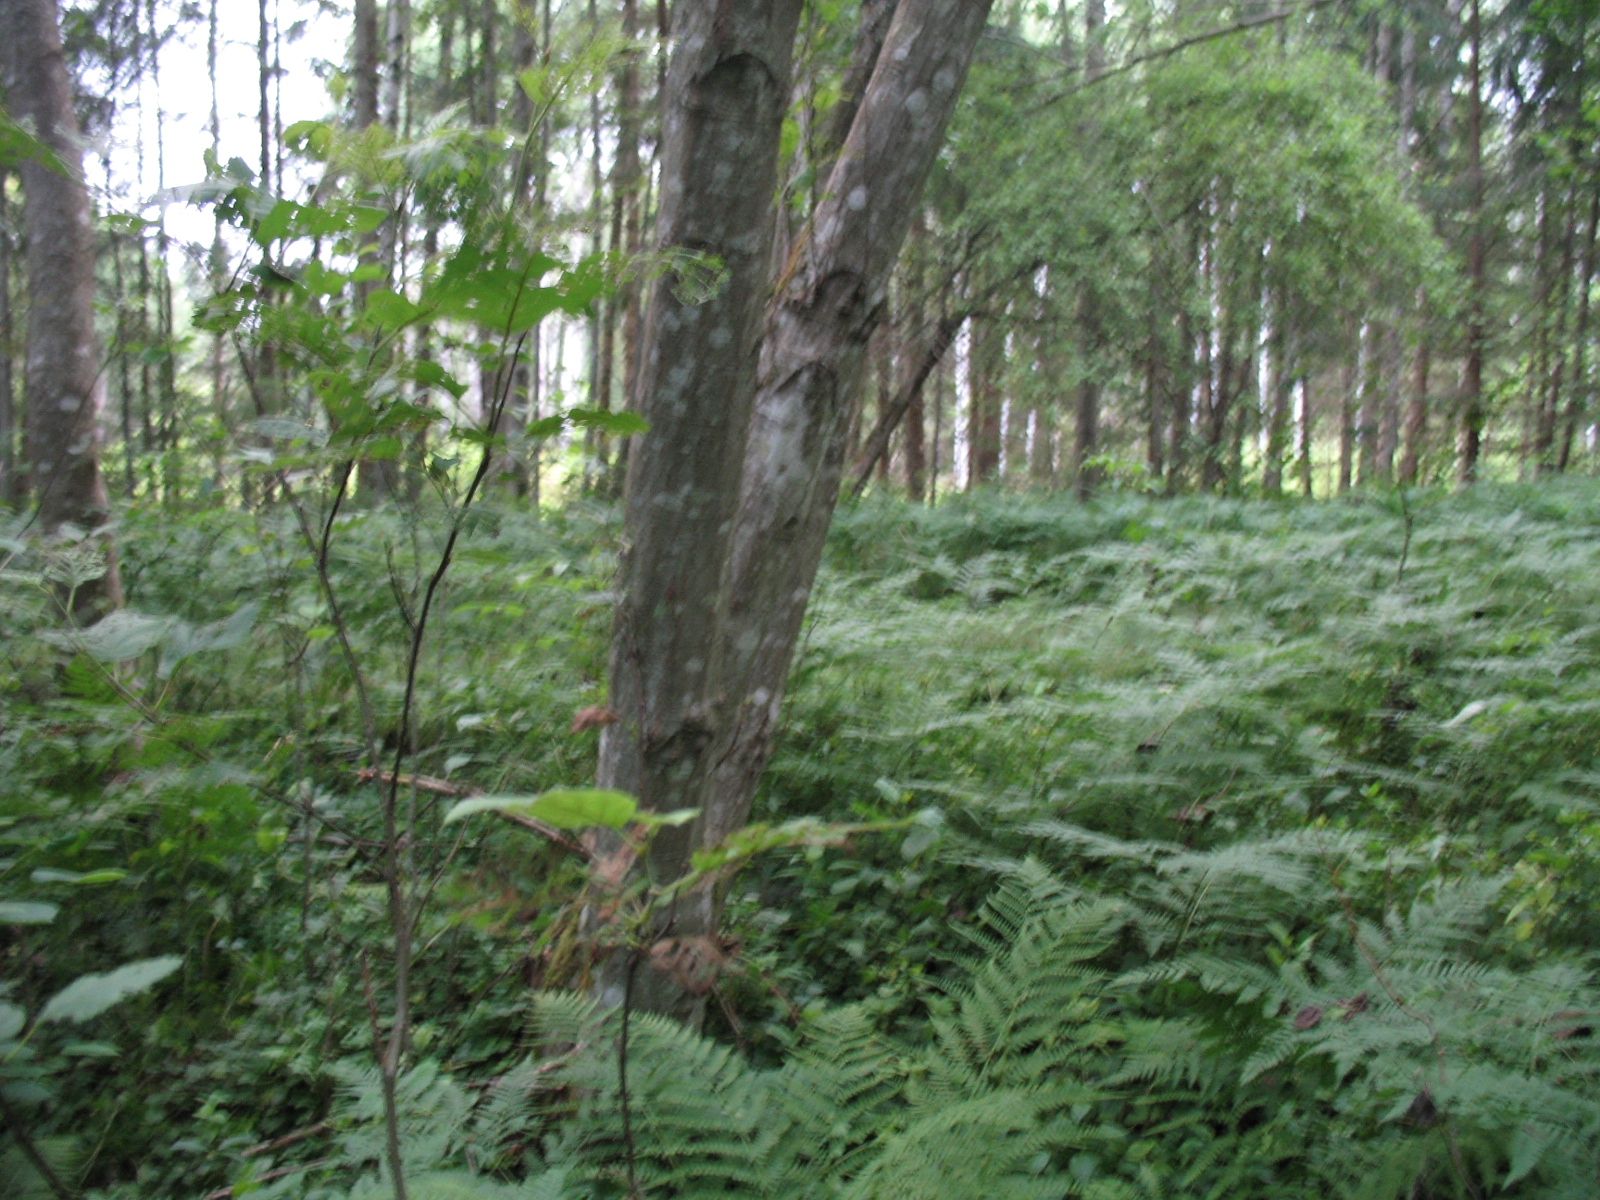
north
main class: Woodland
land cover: Broadleaved woodland
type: non-riverine alder, birch or aspen forest
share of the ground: > 75 %
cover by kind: broadleaved forest trees 80 %, herbaceous plants 10 %, coniferous forest trees 5 %, shrubs 5 %
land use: Forestry
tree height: > 5 m
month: July
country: LV
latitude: 56.4126
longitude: 25.0365
